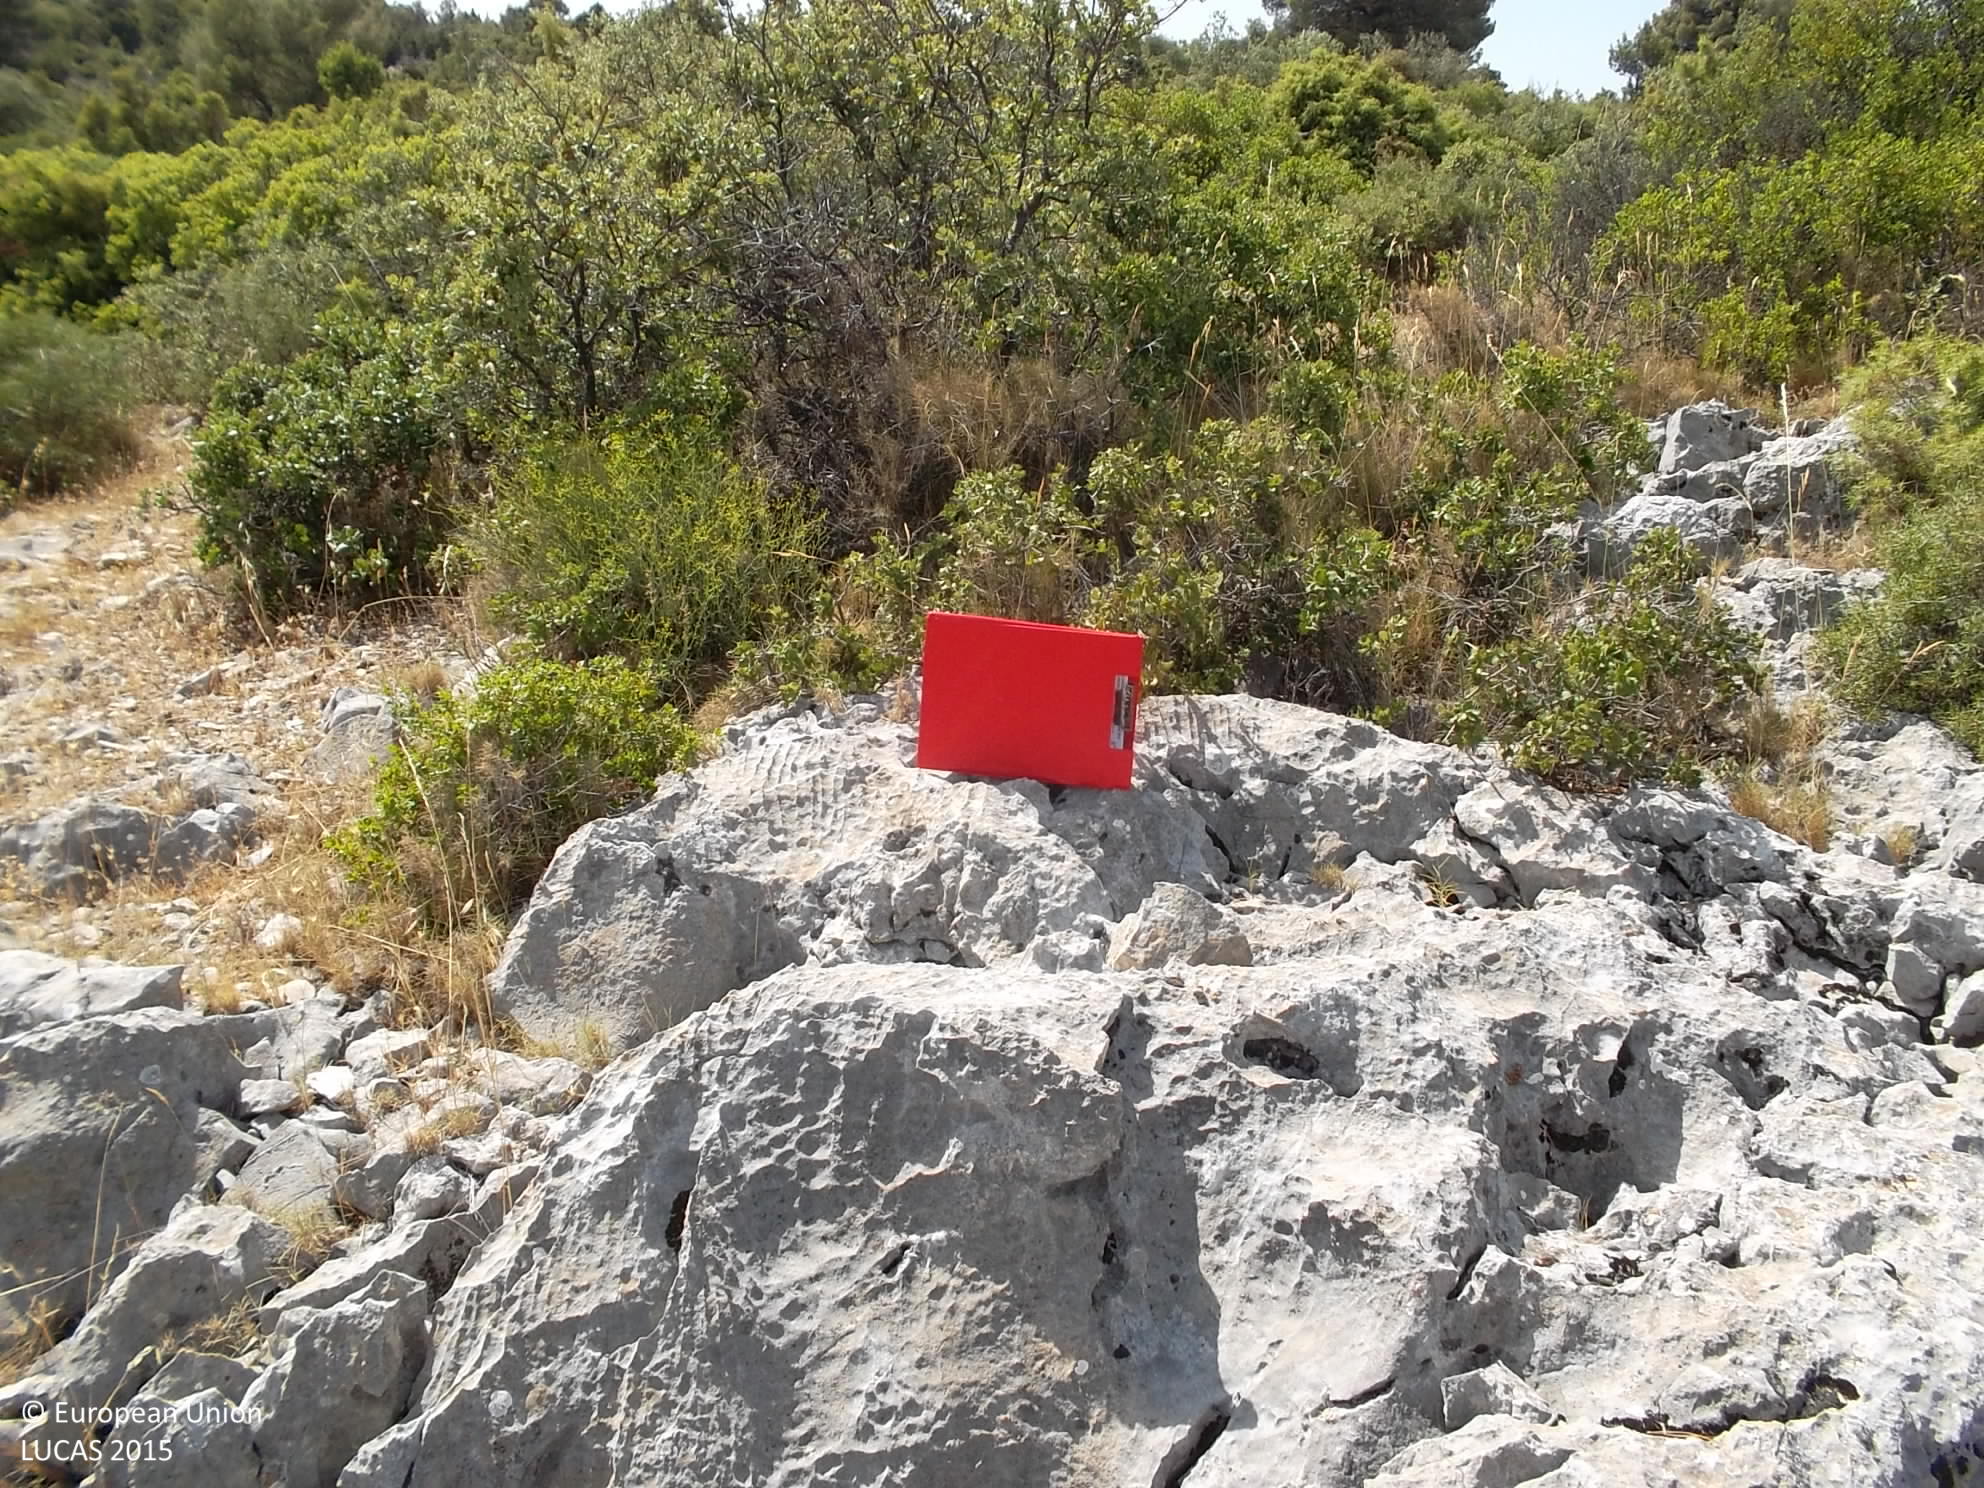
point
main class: Shrubland
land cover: Shrubland with sparse tree cover
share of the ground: 50 - 75 %
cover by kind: consolidated bare surface 60 %, shrubs 35 %, broadleaved forest trees 5 %
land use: Semi-natural and natural areas not in use
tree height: < 5 m
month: June
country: ES
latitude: 37.7666
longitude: -2.8765
